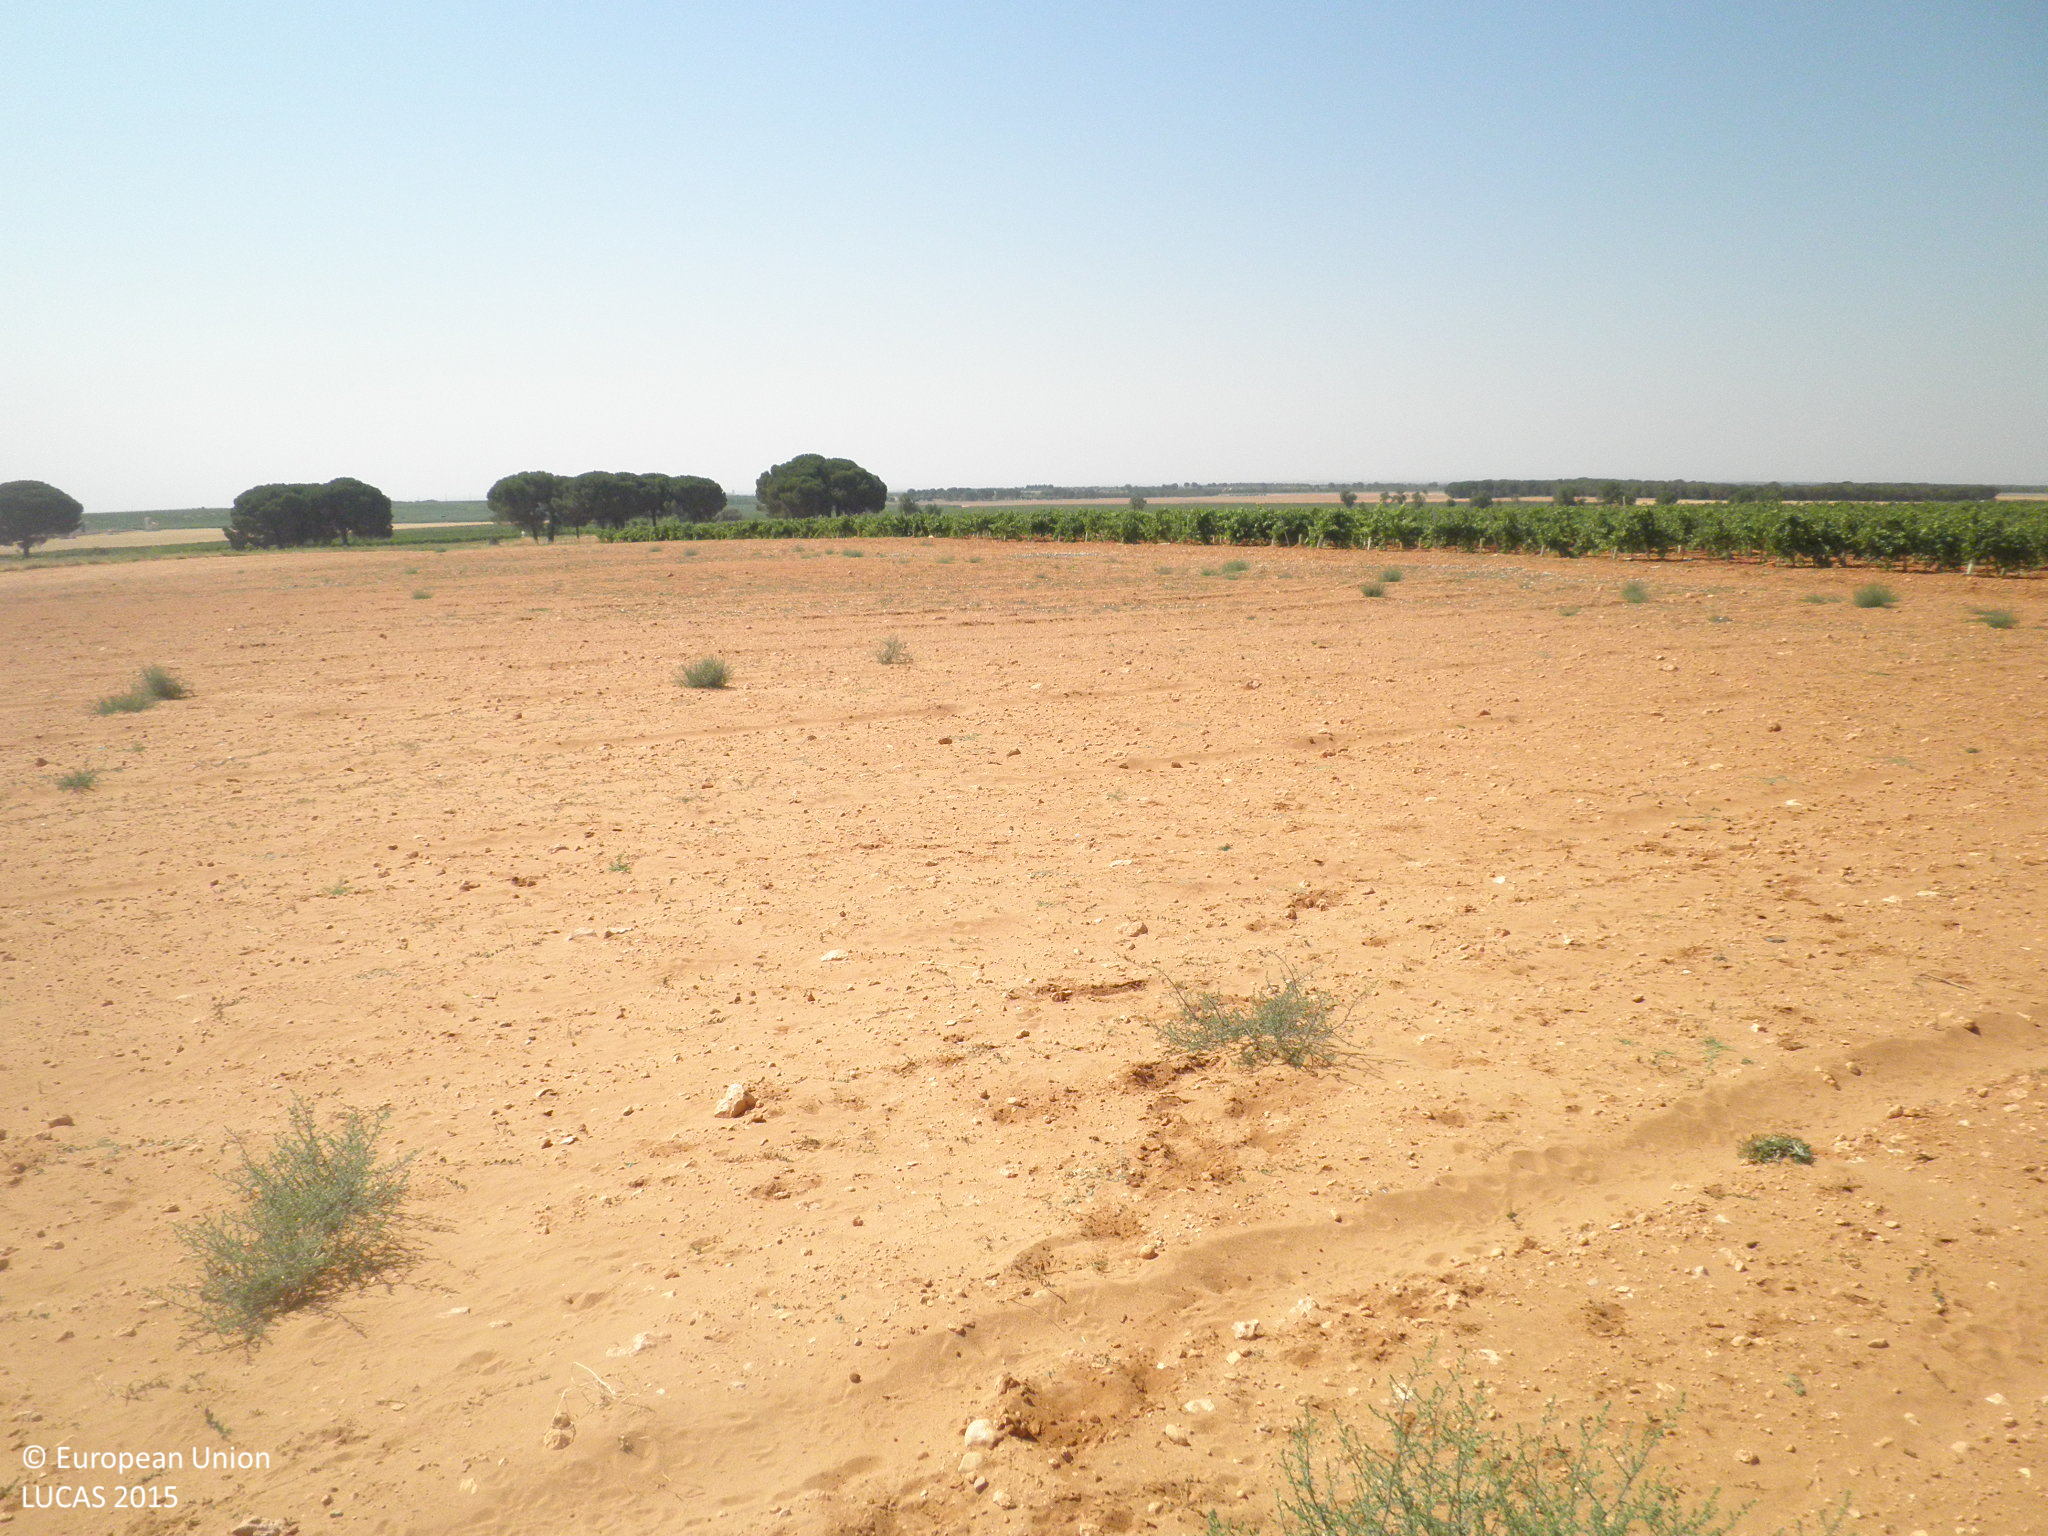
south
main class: Grassland
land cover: Spontaneously vegetated surfaces
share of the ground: 10 - 25 %
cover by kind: unconsolidated bare surface 90 %, herbaceous plants 10 %
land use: Fallow land
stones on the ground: 10 - 25 %
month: July
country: ES
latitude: 39.4339
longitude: -2.5944
